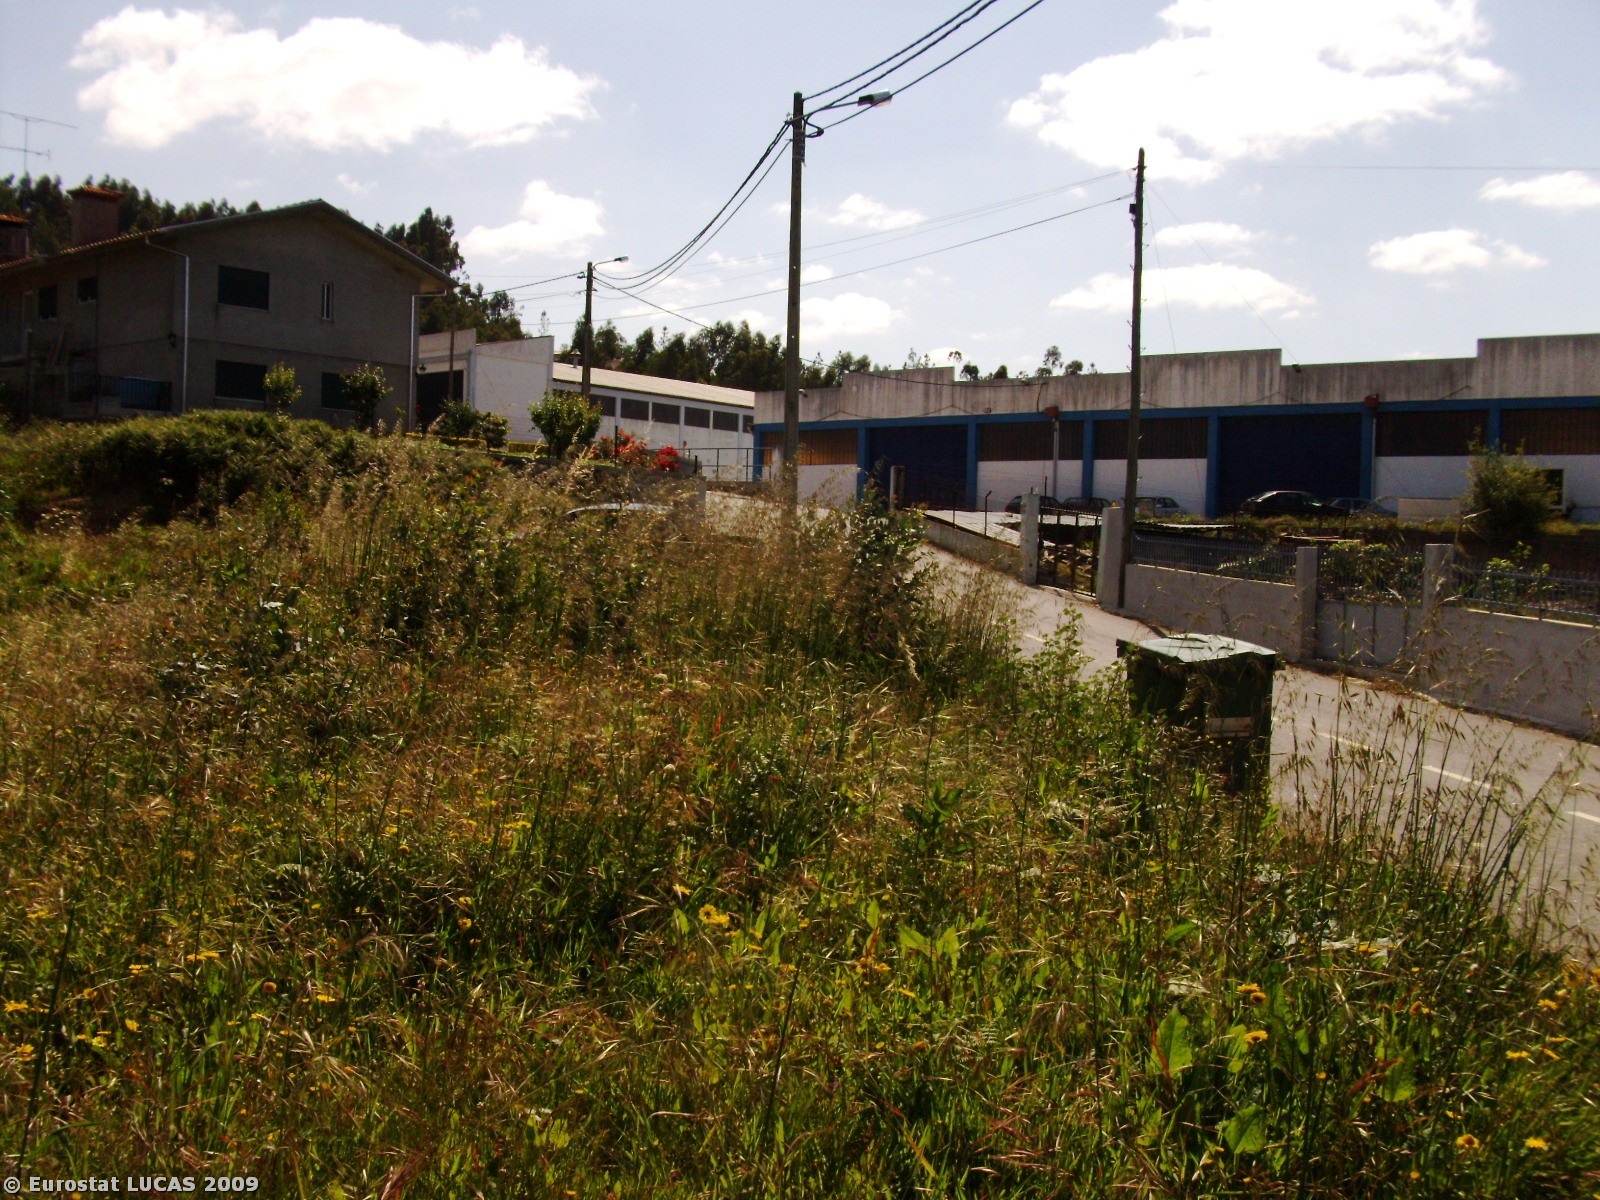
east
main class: Woodland
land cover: Broadleaved woodland
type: plantations and self-sown exotic forest
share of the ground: 25 - 50 %
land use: Forestry
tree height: > 5 m
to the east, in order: Broadleaved woodland; Artificial constructions in urban areas; Broadleaved woodland; Artificial constructions in urban areas; Tracks; Broadleaved woodland; Tracks
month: May
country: PT
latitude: 40.8893
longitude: -8.5303
